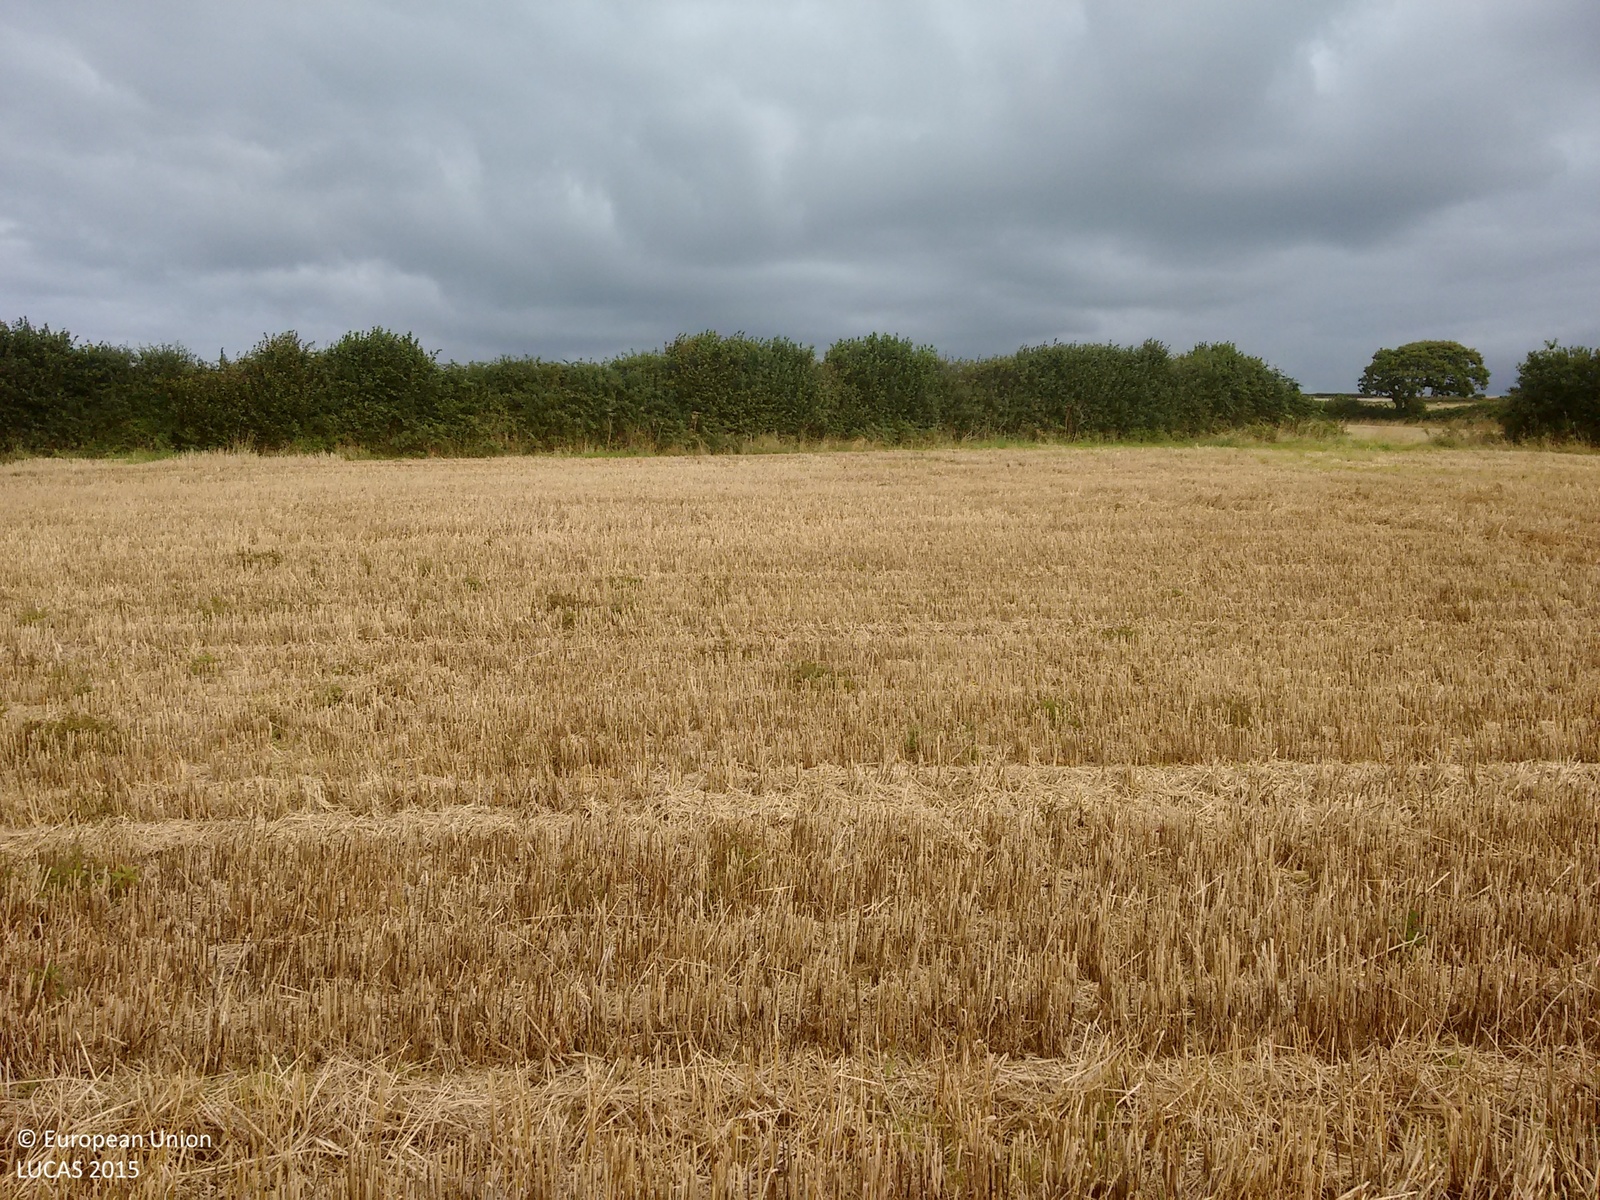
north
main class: Cropland
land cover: Barley
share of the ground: > 75 %
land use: Agriculture (excluding fallow land and kitchen gardens)
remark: Harvested field
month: September
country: GB
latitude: 50.3941
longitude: -4.9840
